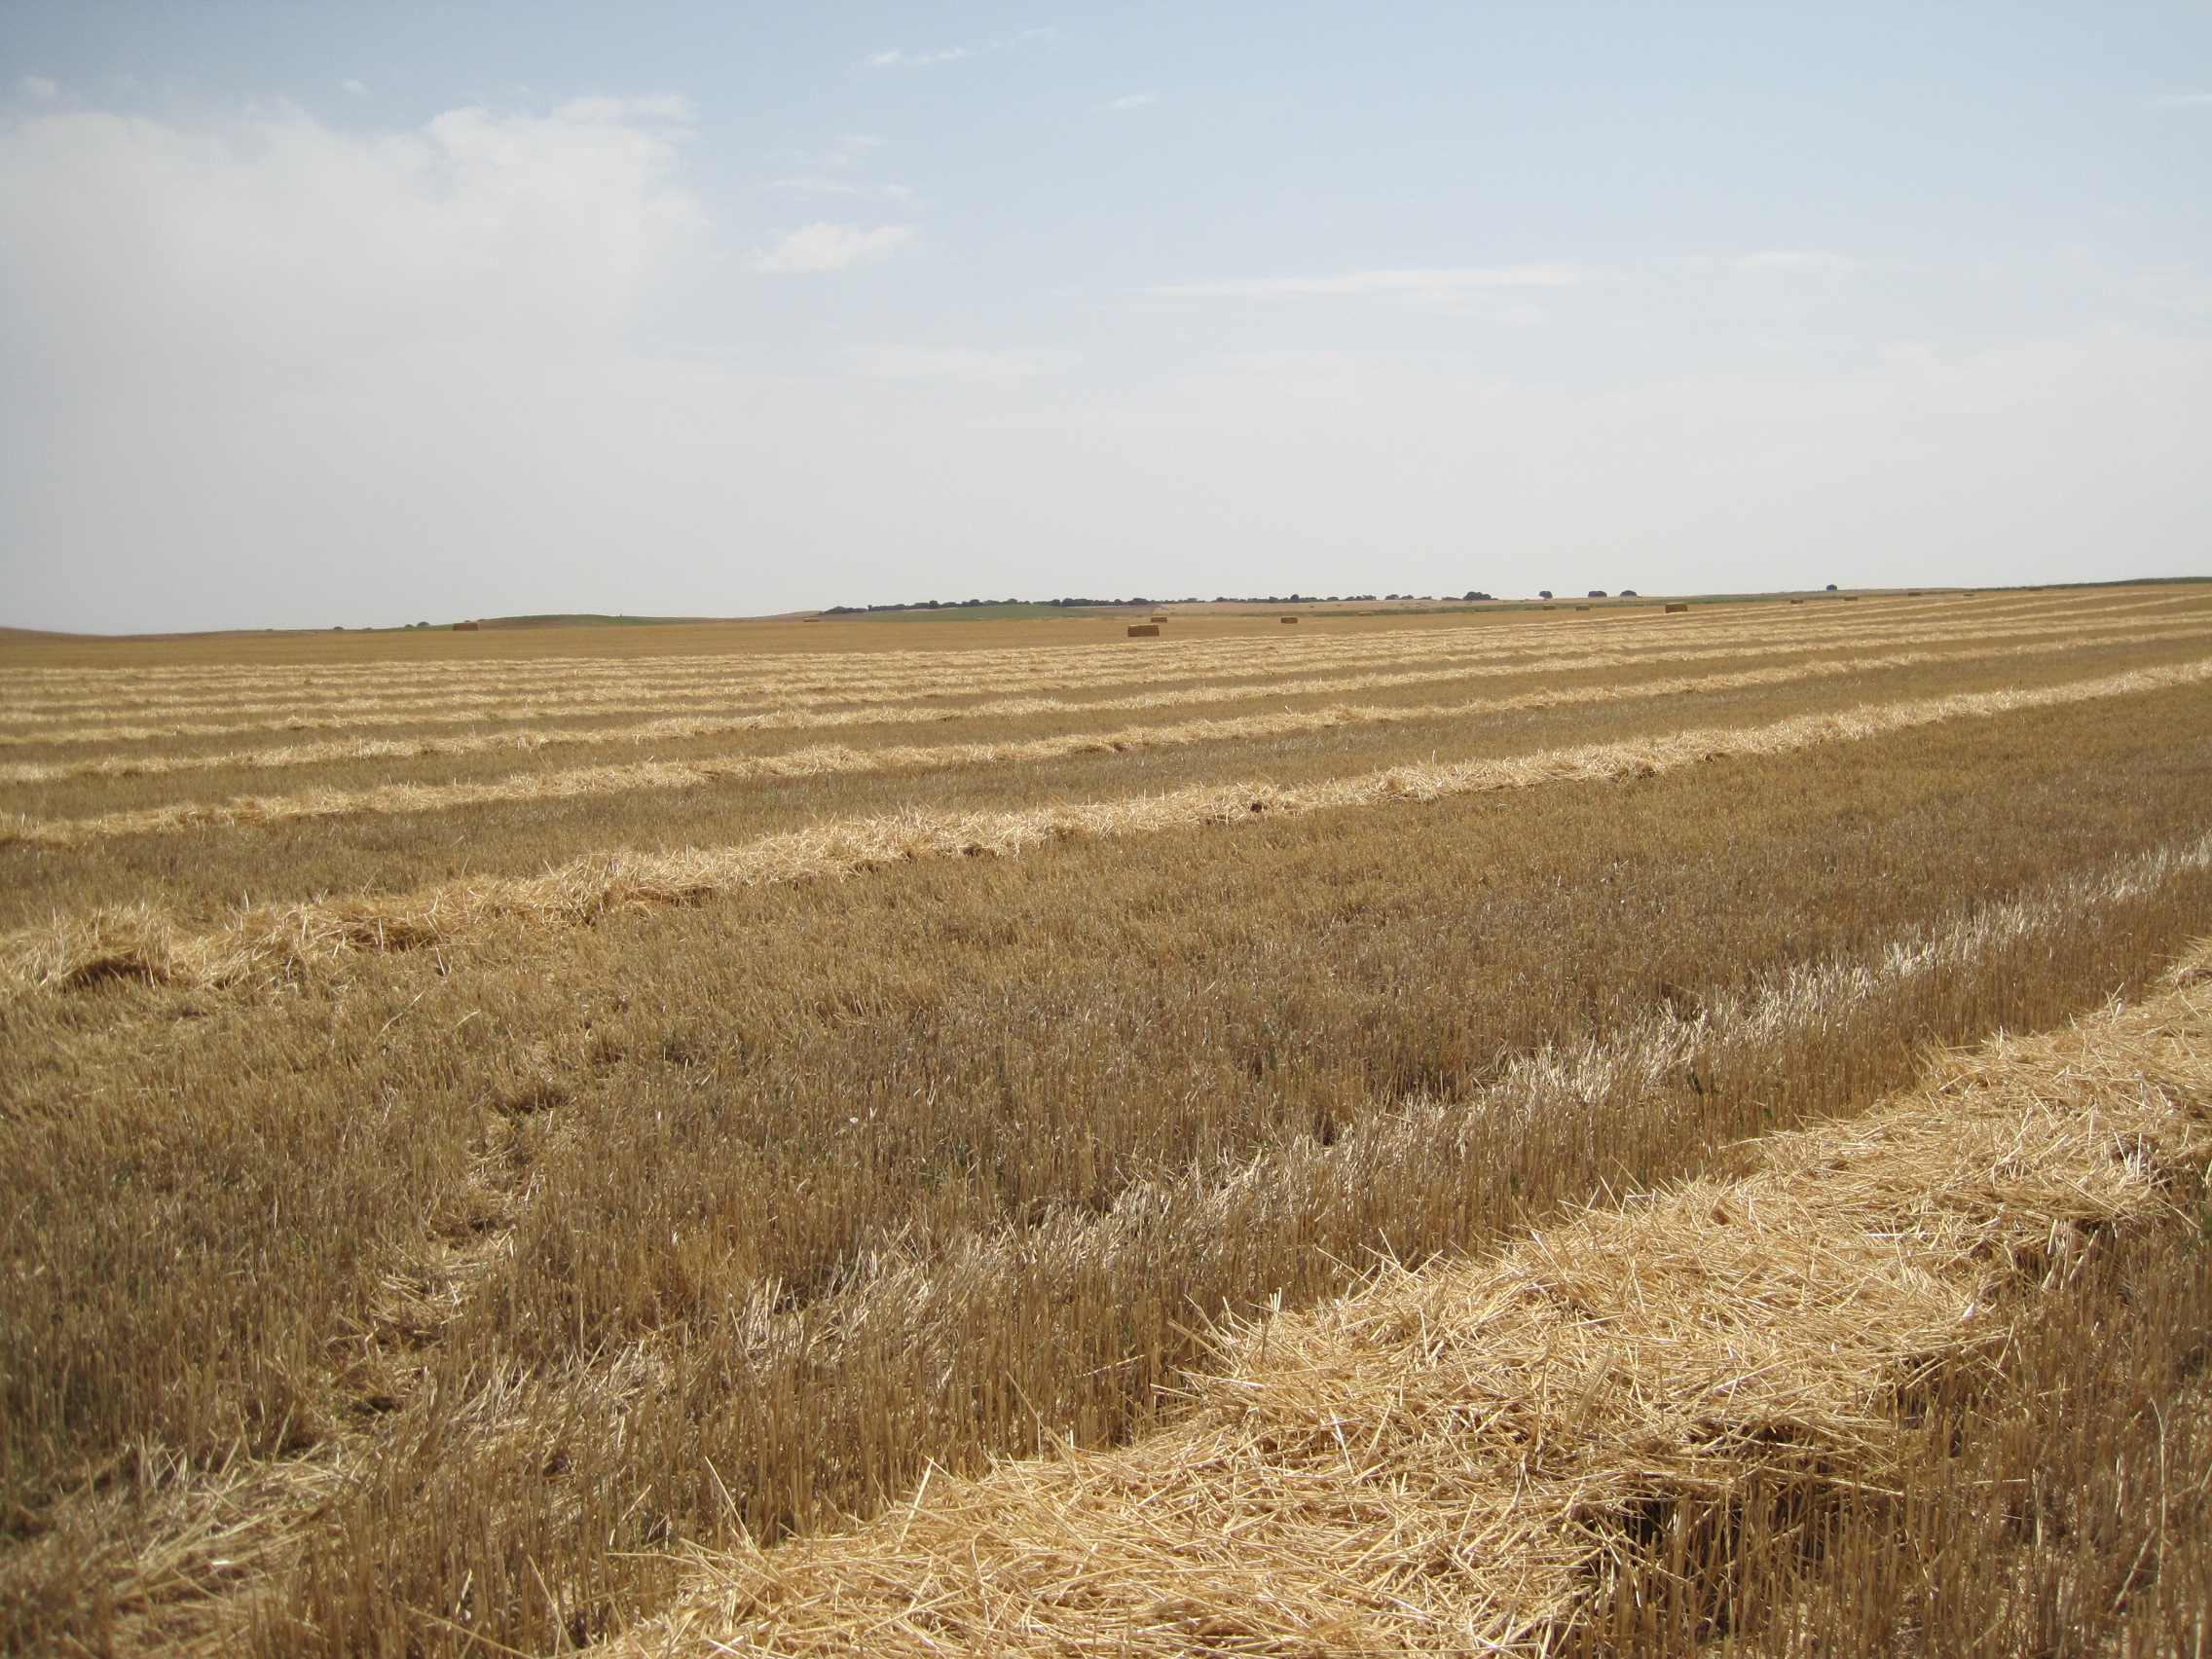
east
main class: Cropland
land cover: Common wheat
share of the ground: < 10 %
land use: Agriculture (excluding fallow land and kitchen gardens)
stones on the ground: 10 - 25 %
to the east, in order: Common wheat; Grass margins; Barley
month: July
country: ES
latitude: 41.7683
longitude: -5.5927
